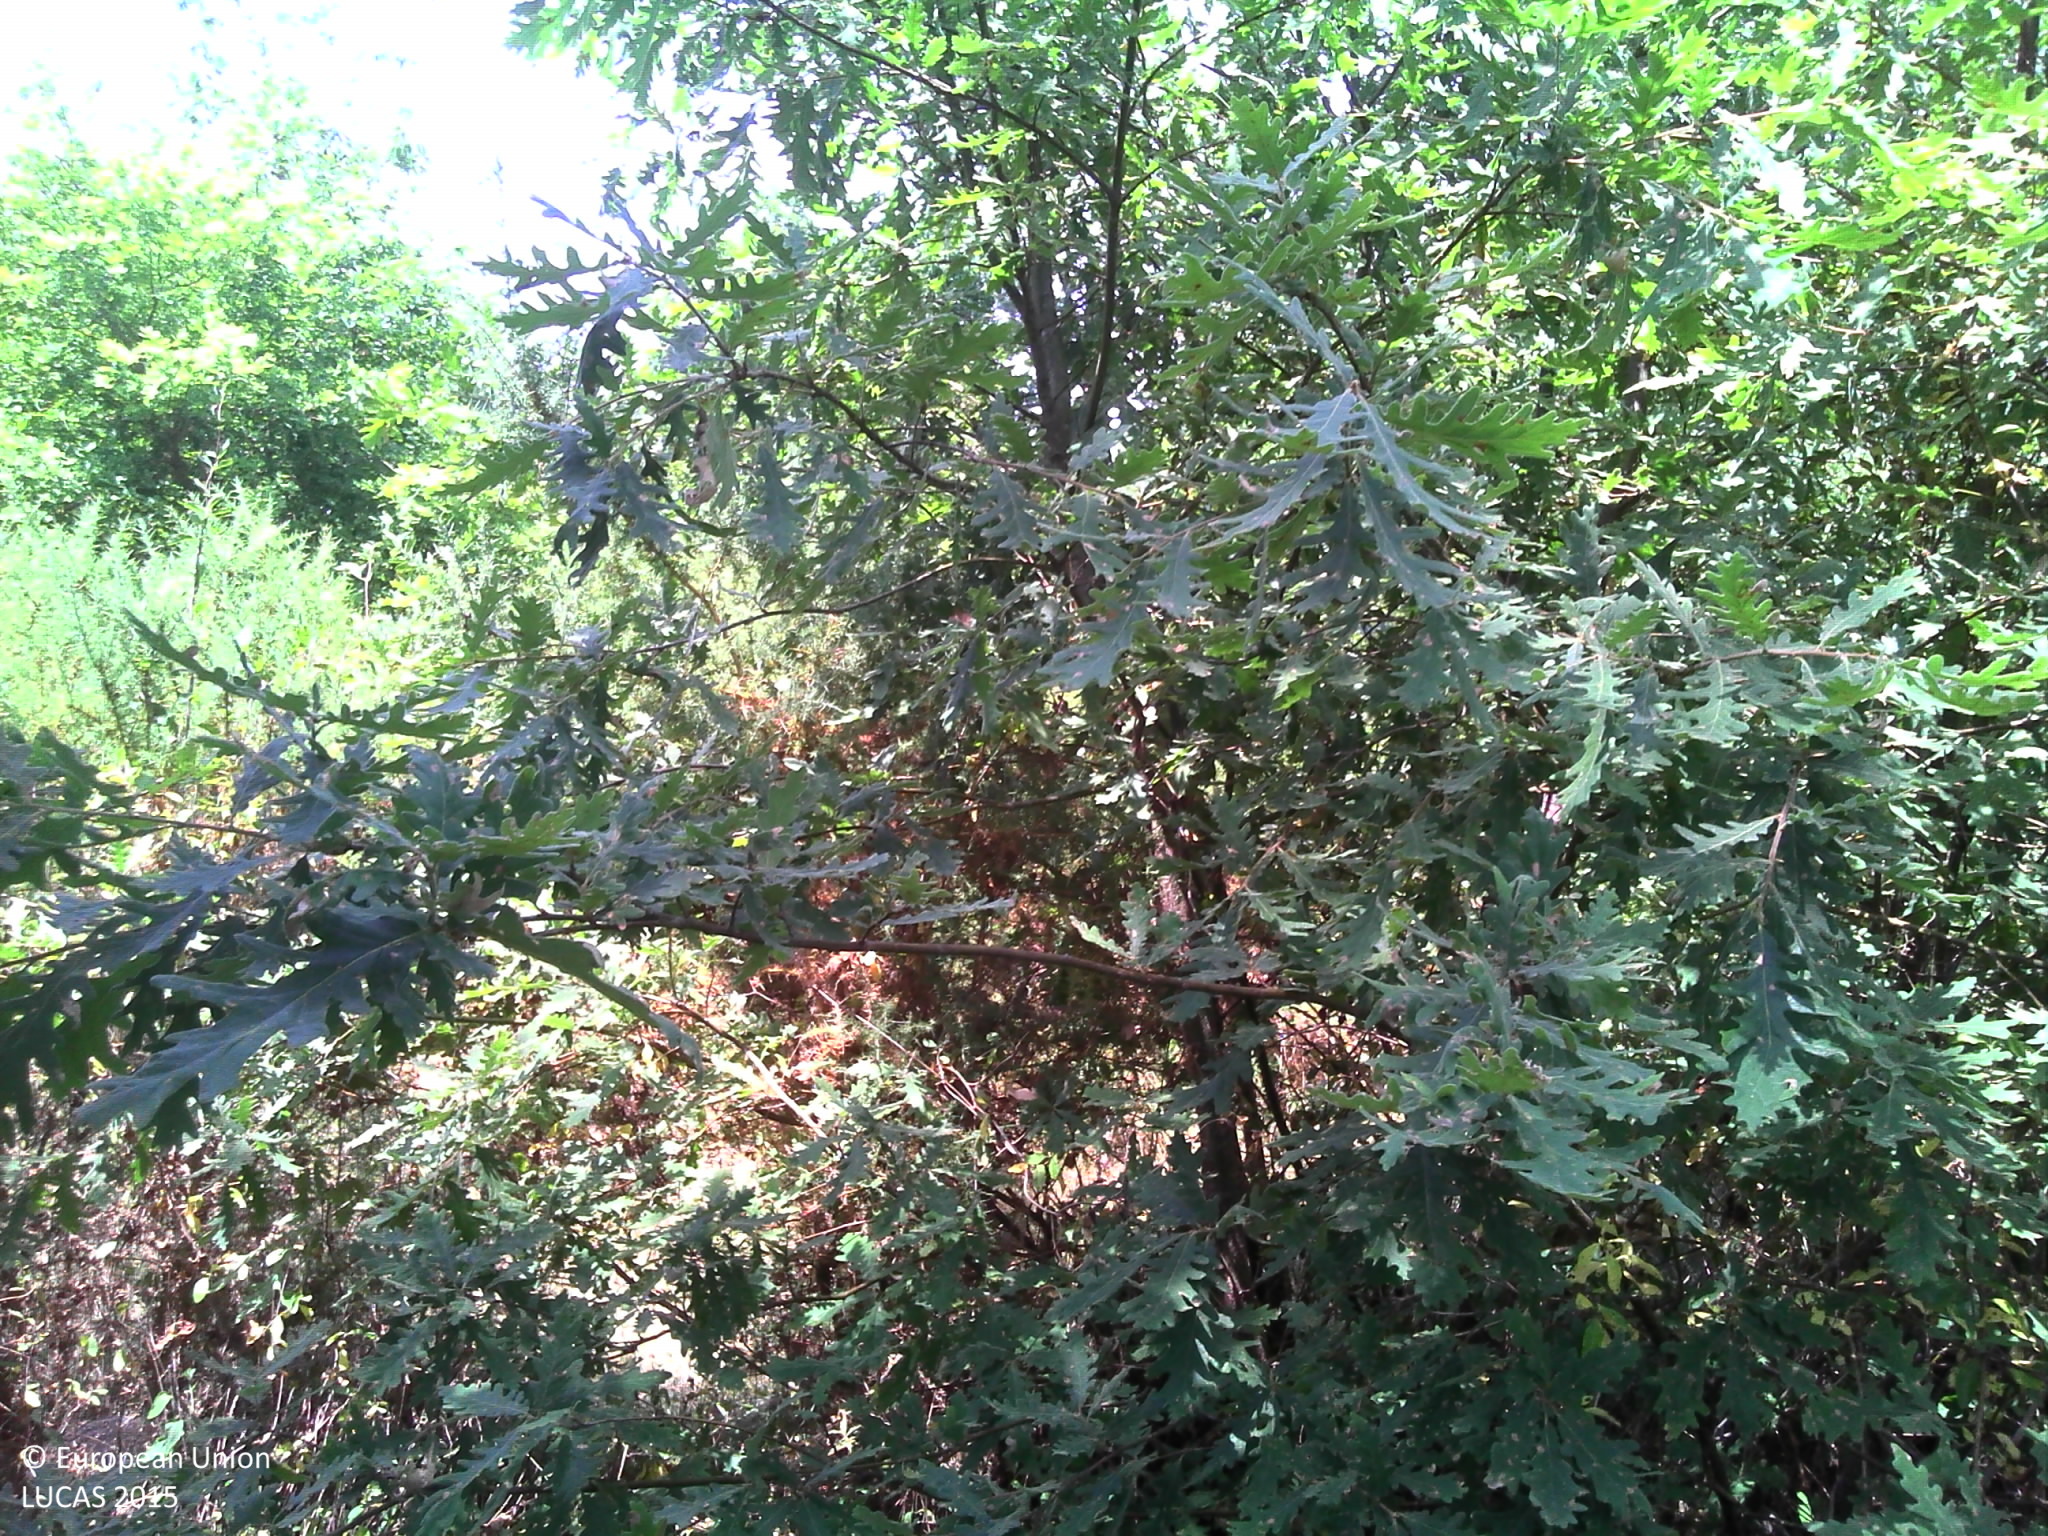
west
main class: Woodland
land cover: Broadleaved woodland
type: thermophilous deciduous forest
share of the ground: > 75 %
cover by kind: broadleaved forest trees 85 %, coniferous forest trees 5 %, shrubs 5 %, herbaceous plants 5 %
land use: Semi-natural and natural areas not in use
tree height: < 5 m
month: July
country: FR
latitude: 44.3803
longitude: -0.6727
